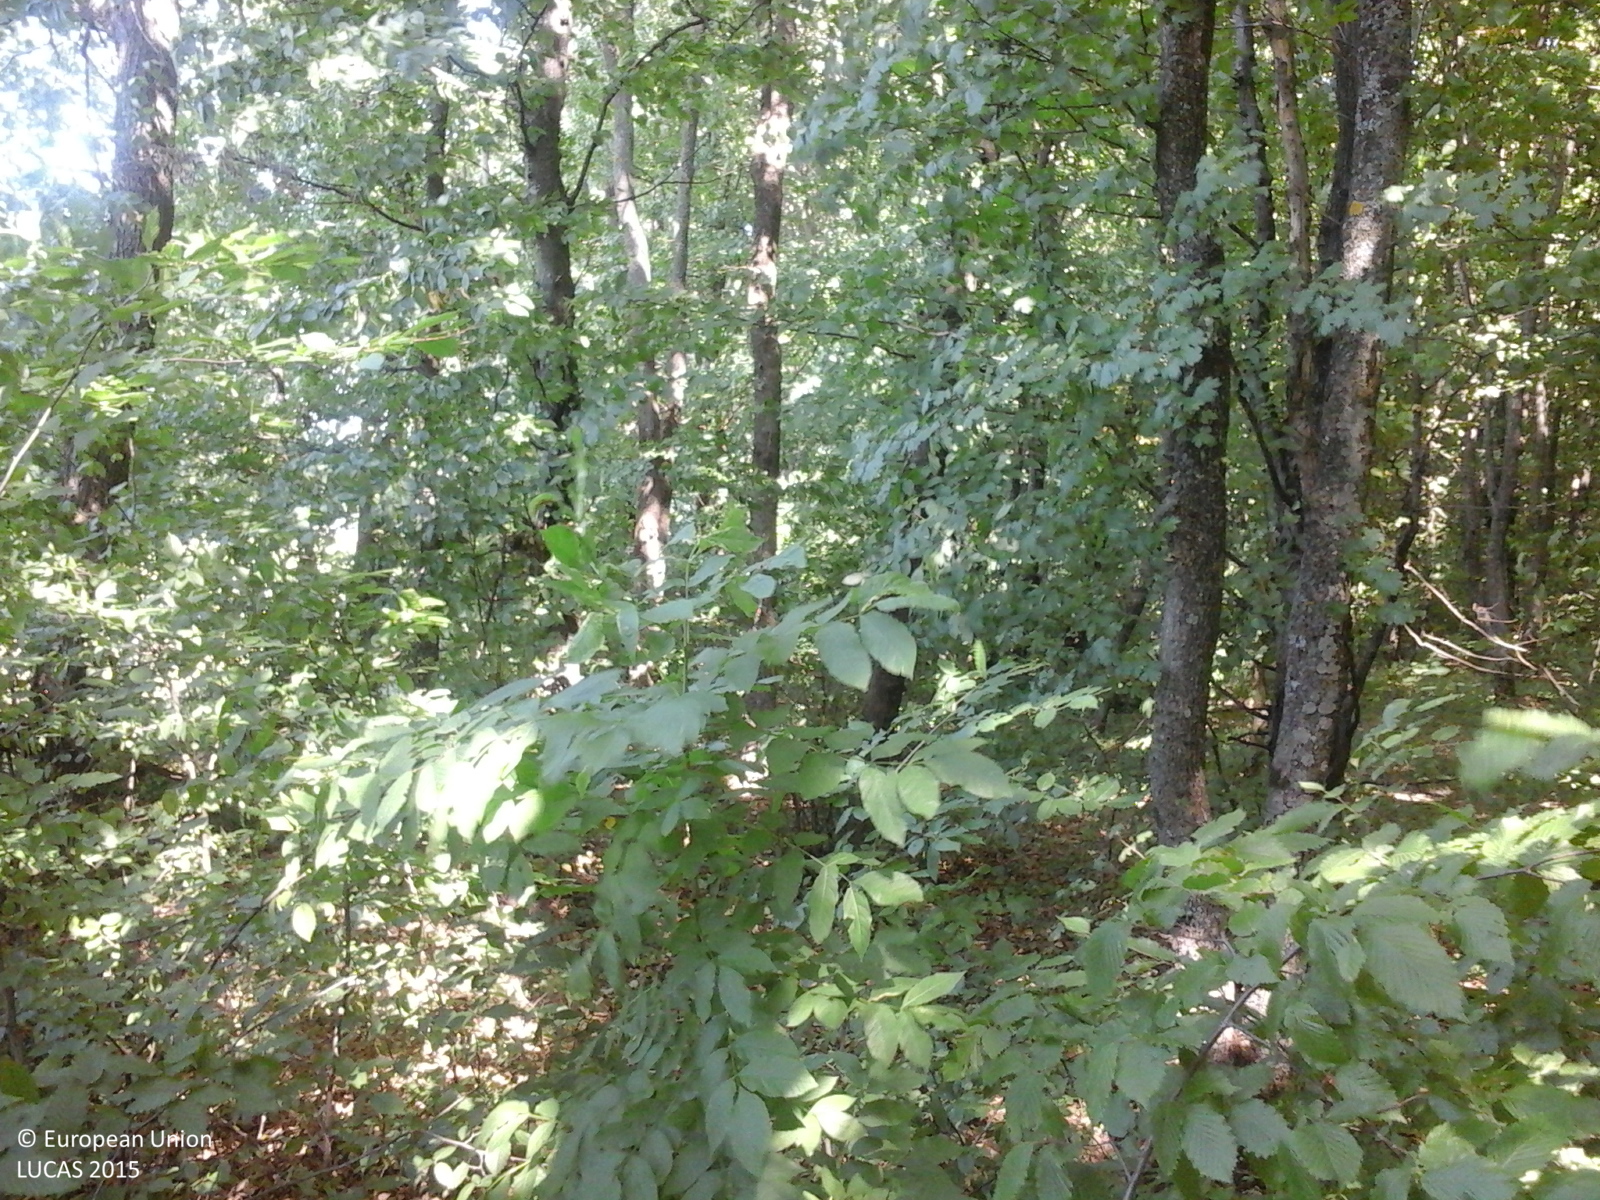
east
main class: Woodland
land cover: Broadleaved woodland
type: acidophilous oak and oak-birch forest
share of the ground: > 75 %
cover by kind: broadleaved forest trees 85 %, herbaceous plants 10 %, shrubs 5 %
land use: Forestry
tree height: > 5 m
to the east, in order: Broadleaved woodland; Tracks; Broadleaved woodland
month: June
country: RO
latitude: 46.7619
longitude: 28.0008
